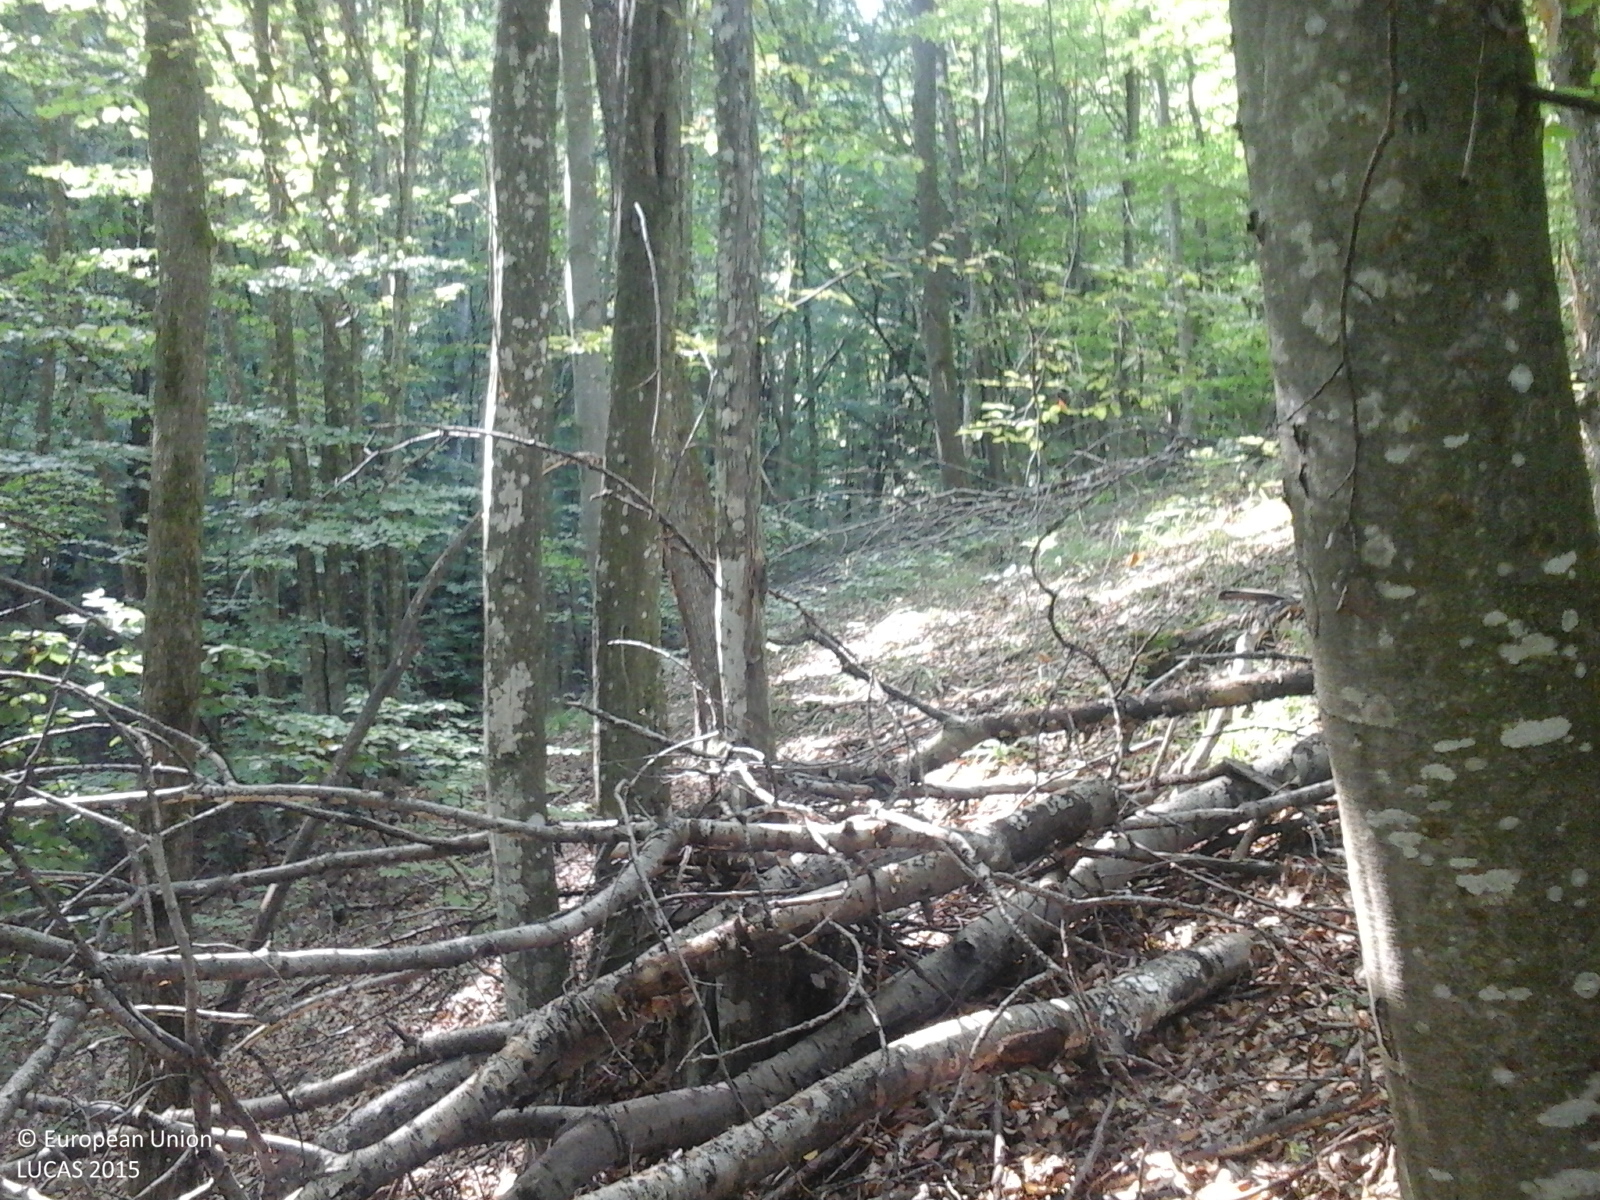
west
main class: Woodland
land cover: Broadleaved woodland
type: mesophytic deciduous forest
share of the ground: > 75 %
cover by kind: broadleaved forest trees 100 %
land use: Forestry
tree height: > 5 m
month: September
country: RO
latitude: 47.2548
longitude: 23.8343
